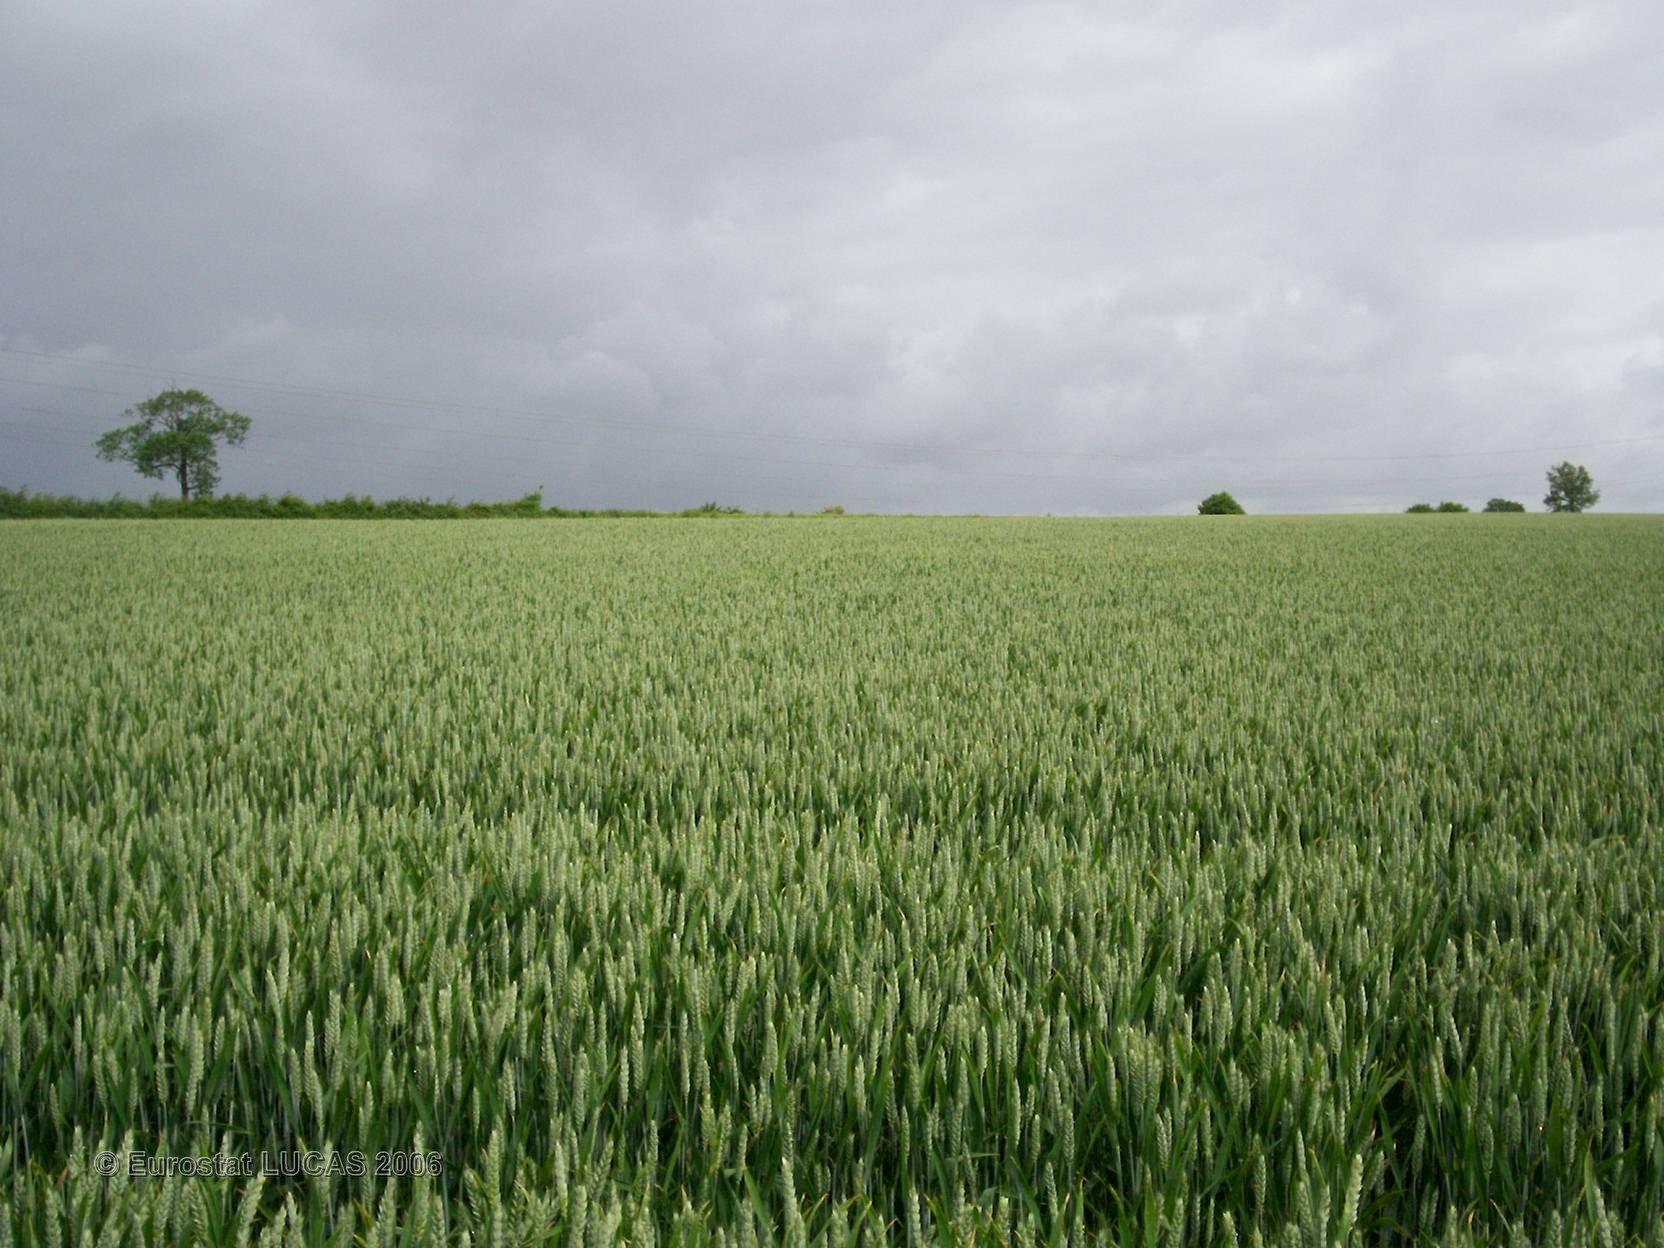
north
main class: Cropland
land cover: Common wheat
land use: Agriculture (excluding fallow land and kitchen gardens)
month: May
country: FR
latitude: 46.4391
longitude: -0.2411
